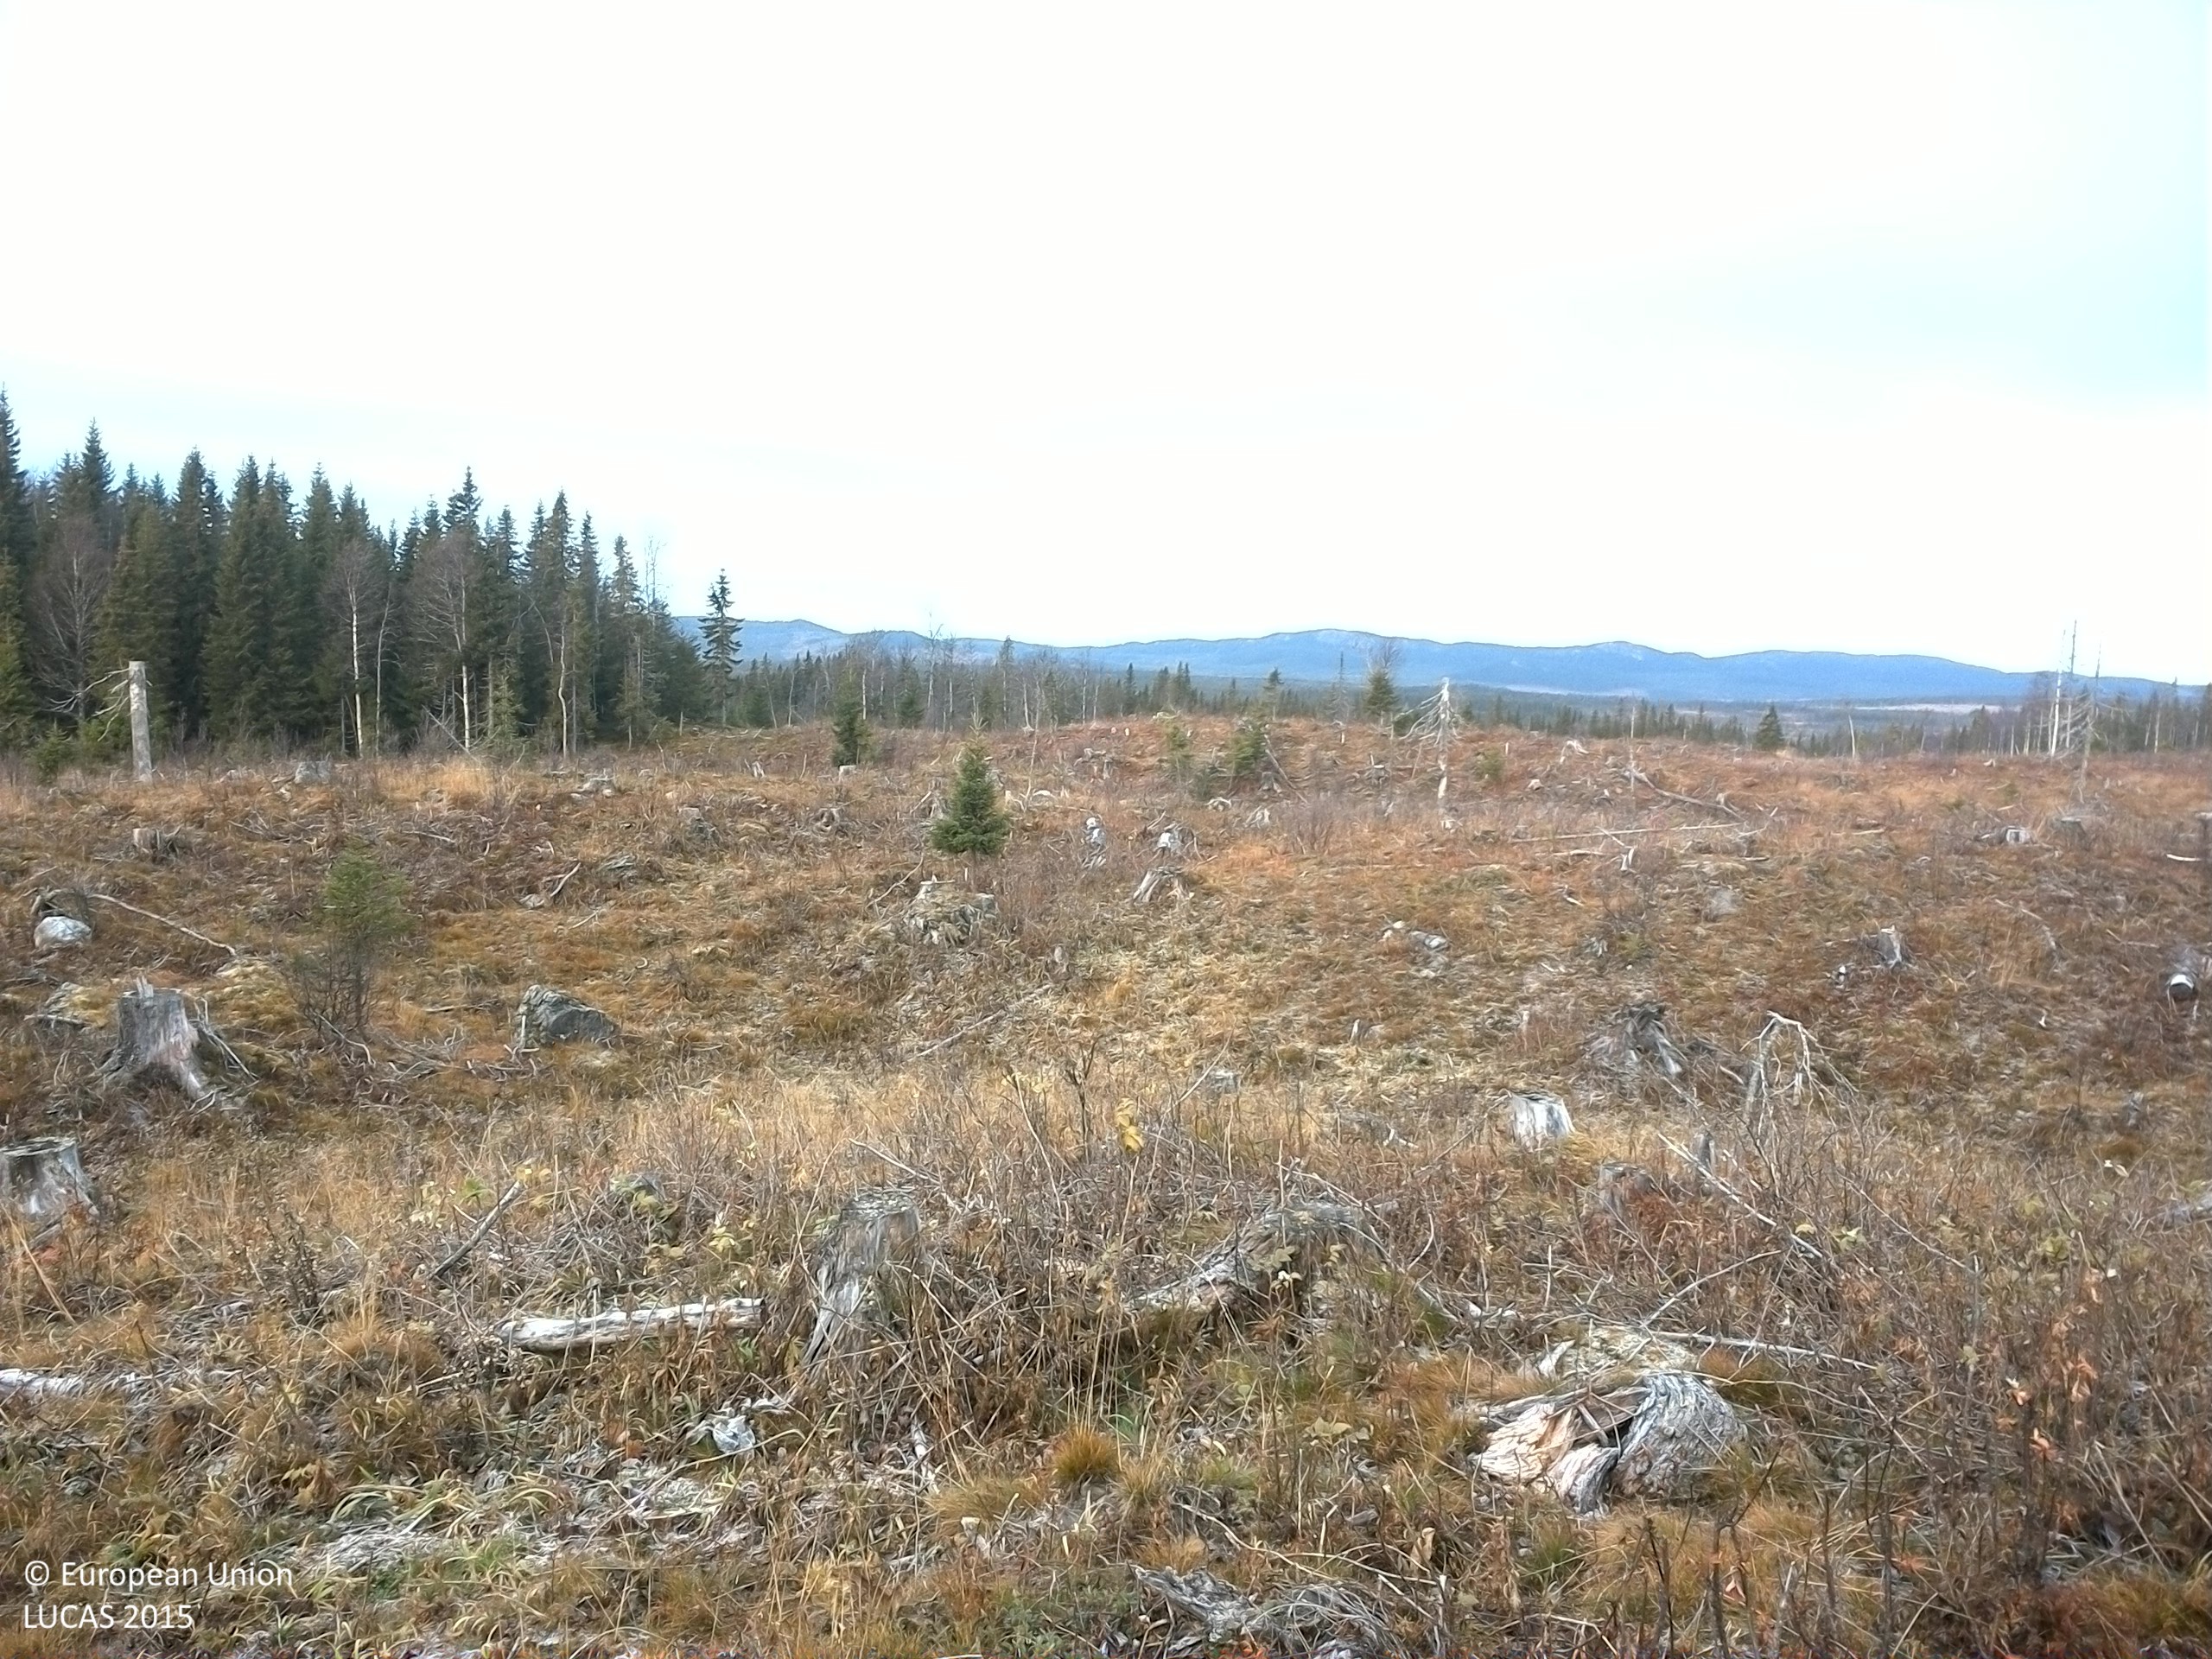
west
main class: Woodland
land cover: Spruce dominated mixed woodland
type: boreal forest
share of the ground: 10 - 25 %
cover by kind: herbaceous plants 55 %, lichens and mosses 20 %, shrubs 15 %, coniferous forest trees 5 %, broadleaved forest trees 5 %
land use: Forestry
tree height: < 5 m
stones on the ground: 25 - 50 %
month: October
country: SE
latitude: 64.1122
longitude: 15.2486
